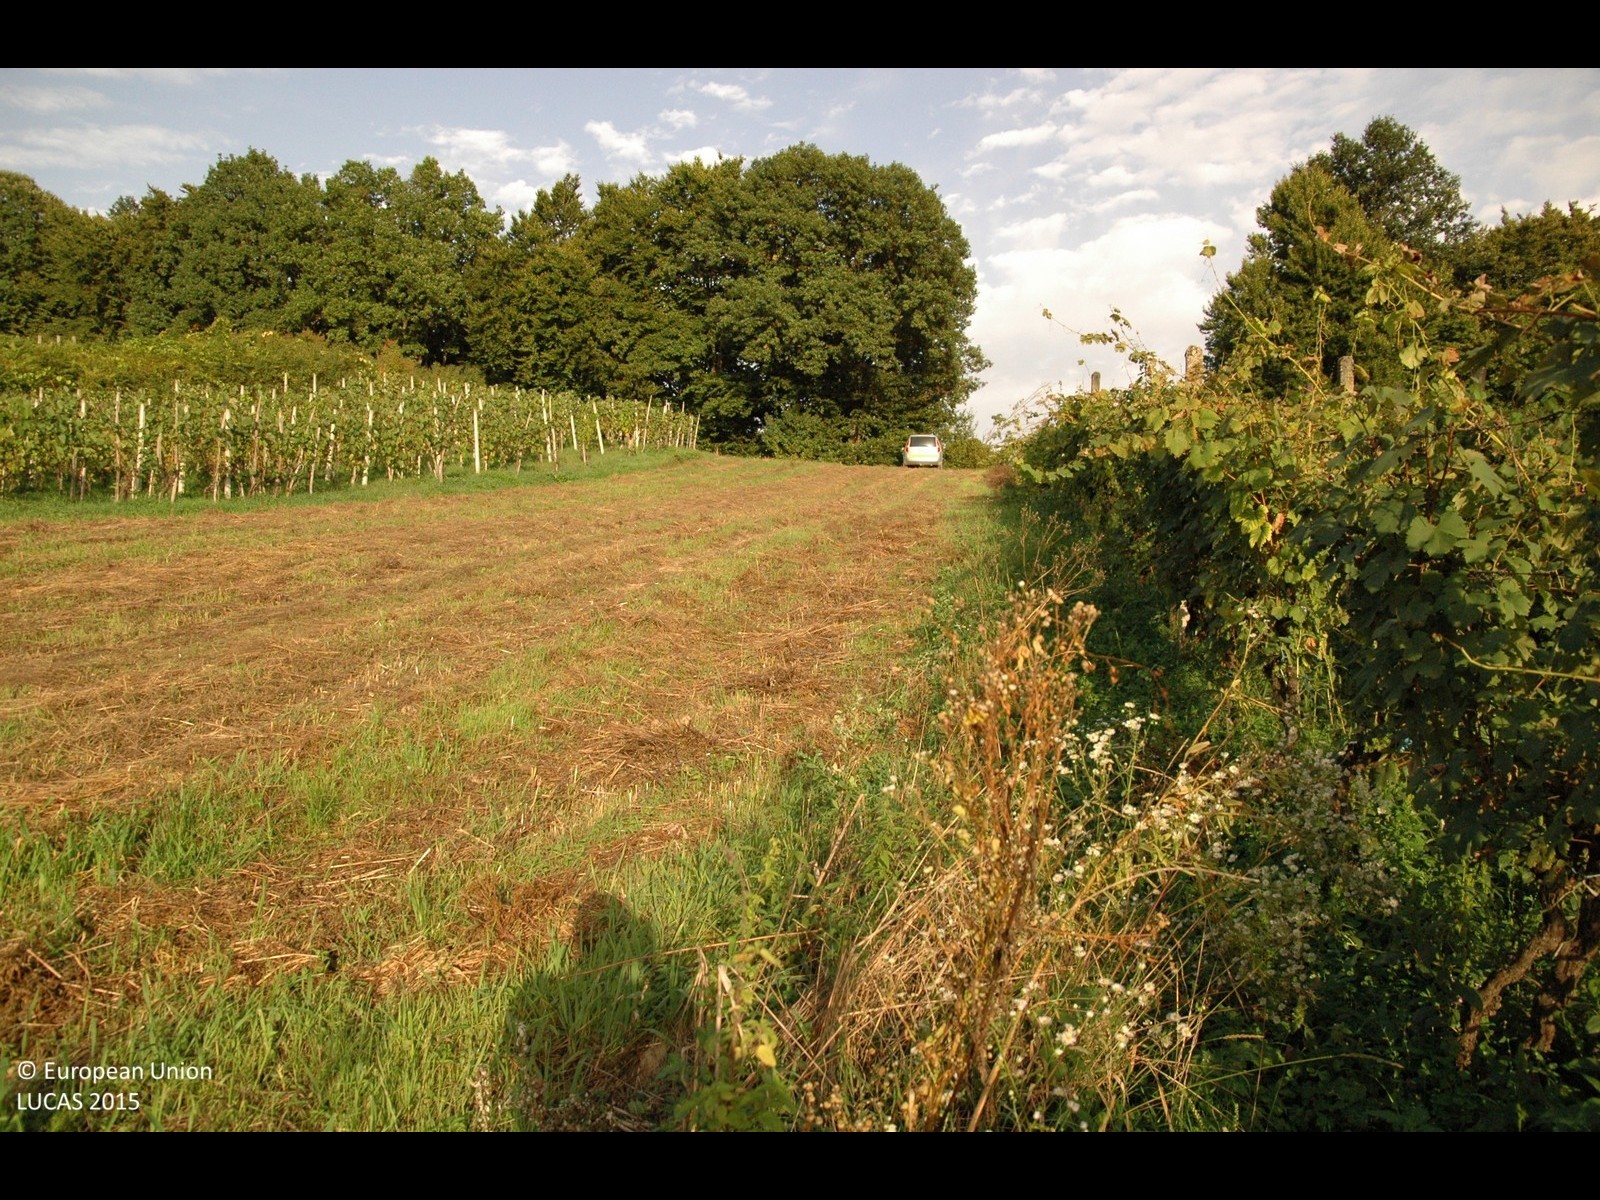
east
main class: Grassland
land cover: Grassland without tree/shrub cover
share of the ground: > 75 %
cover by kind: herbaceous plants 100 %
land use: Agriculture (excluding fallow land and kitchen gardens)
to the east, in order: Grassland without tree/shrub cover; Paved roads, cycling and walking lanes; Broadleaved woodland
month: September
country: HR
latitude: 45.6085
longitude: 15.9339
